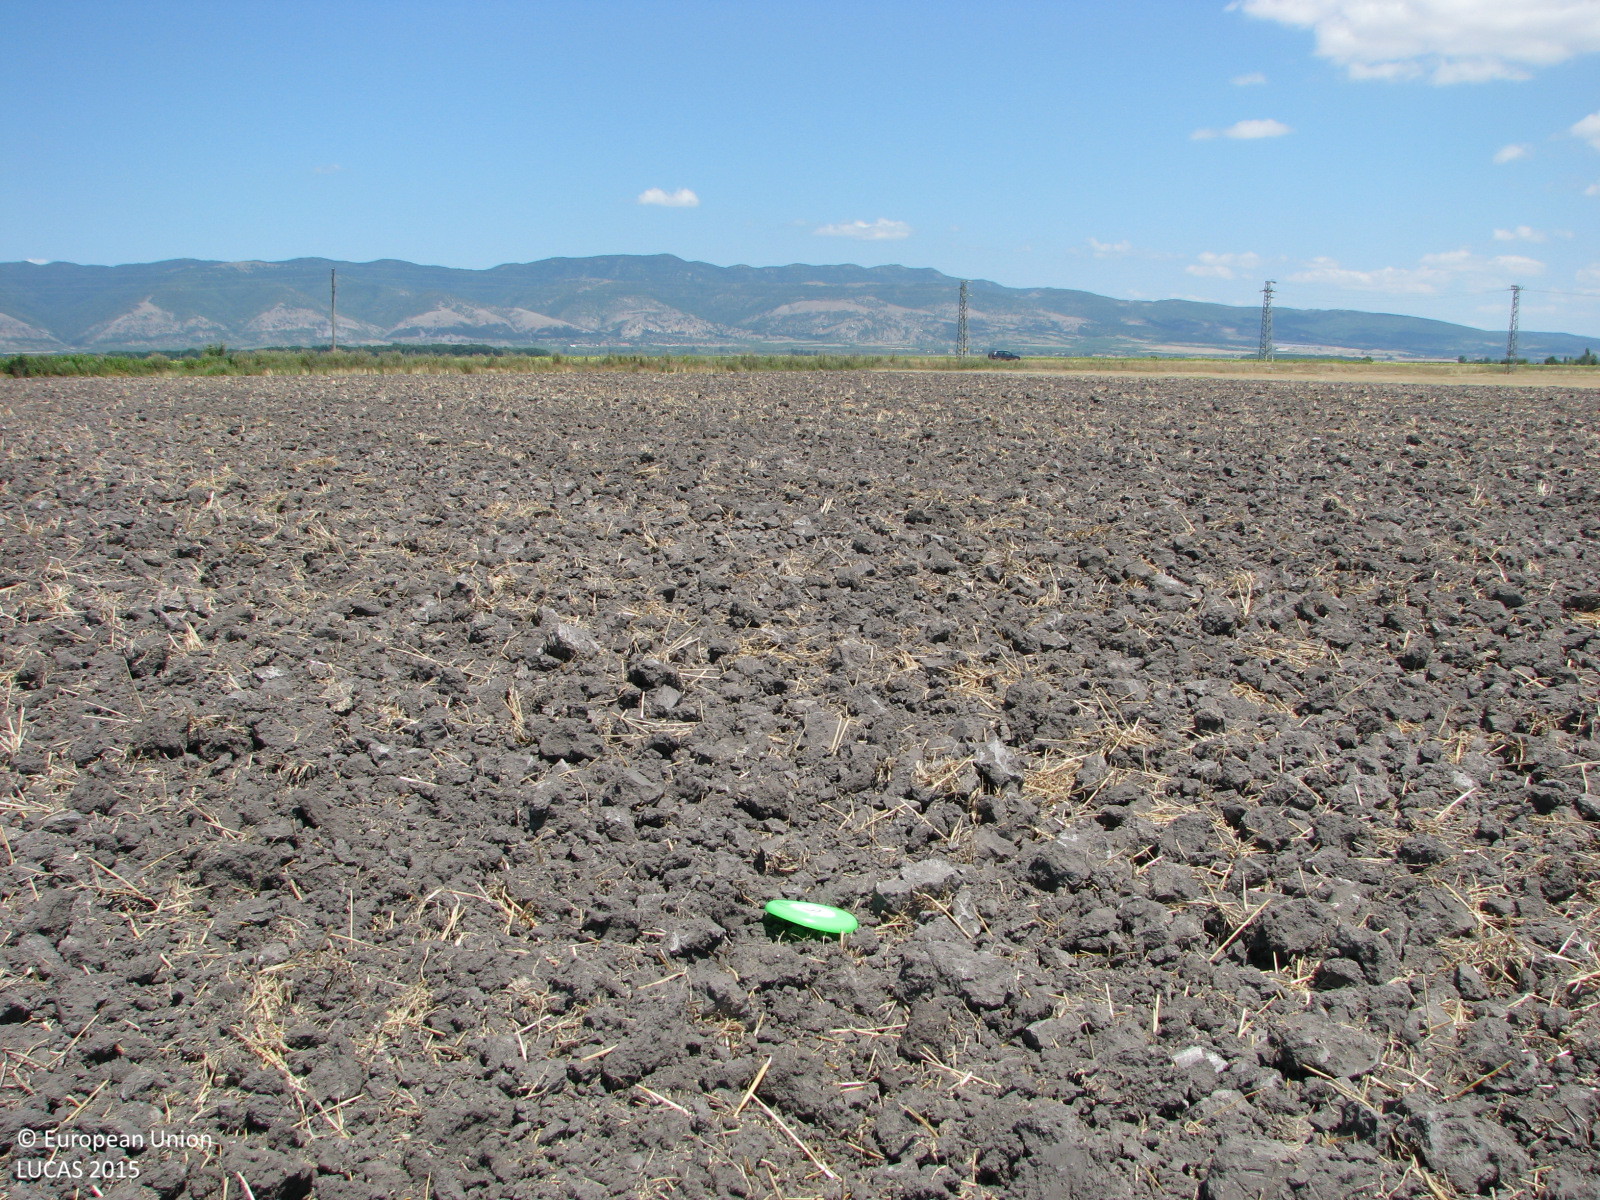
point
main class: Cropland
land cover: Common wheat
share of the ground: < 10 %
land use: Agriculture (excluding fallow land and kitchen gardens)
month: July
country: BG
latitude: 42.6020
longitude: 26.4617
